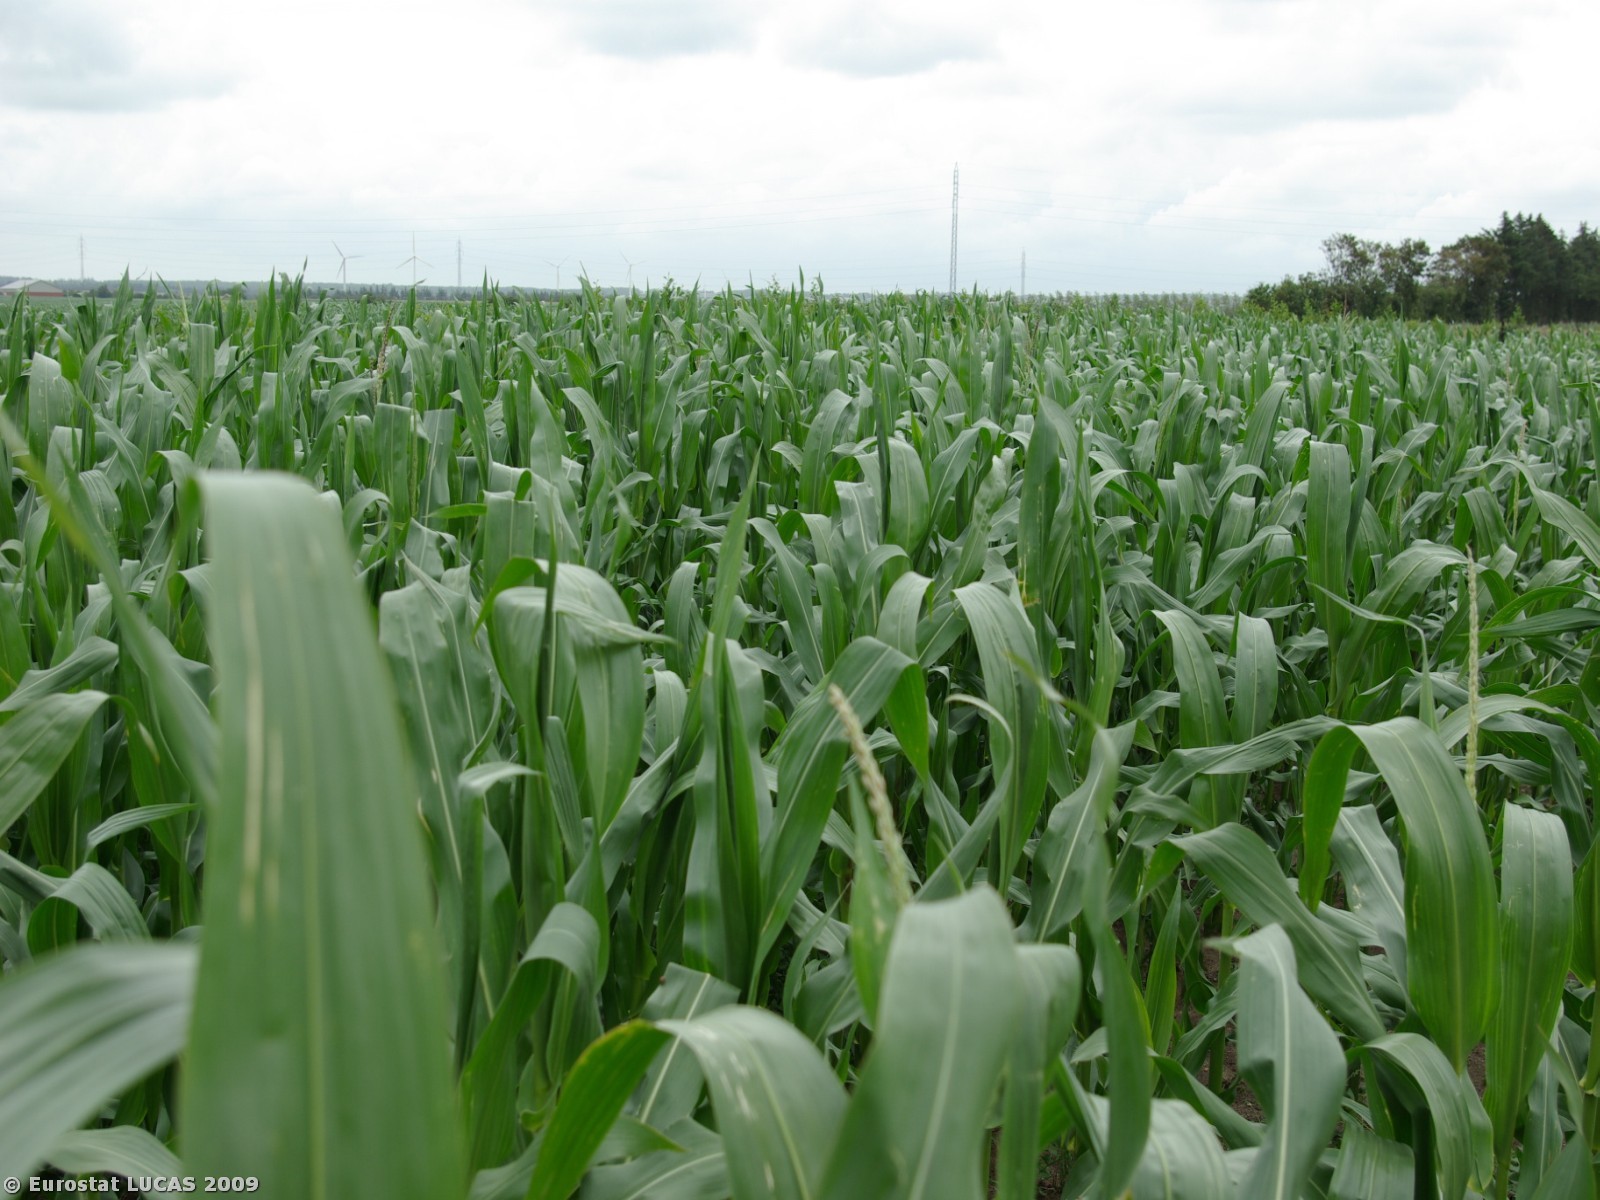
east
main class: Cropland
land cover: Maize
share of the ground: 50 - 75 %
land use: Agriculture (excluding fallow land and kitchen gardens)
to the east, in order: Maize; Broadleaved woodland; Barley; Broadleaved woodland; Tracks
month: July
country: DK
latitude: 55.0858
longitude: 8.8259
